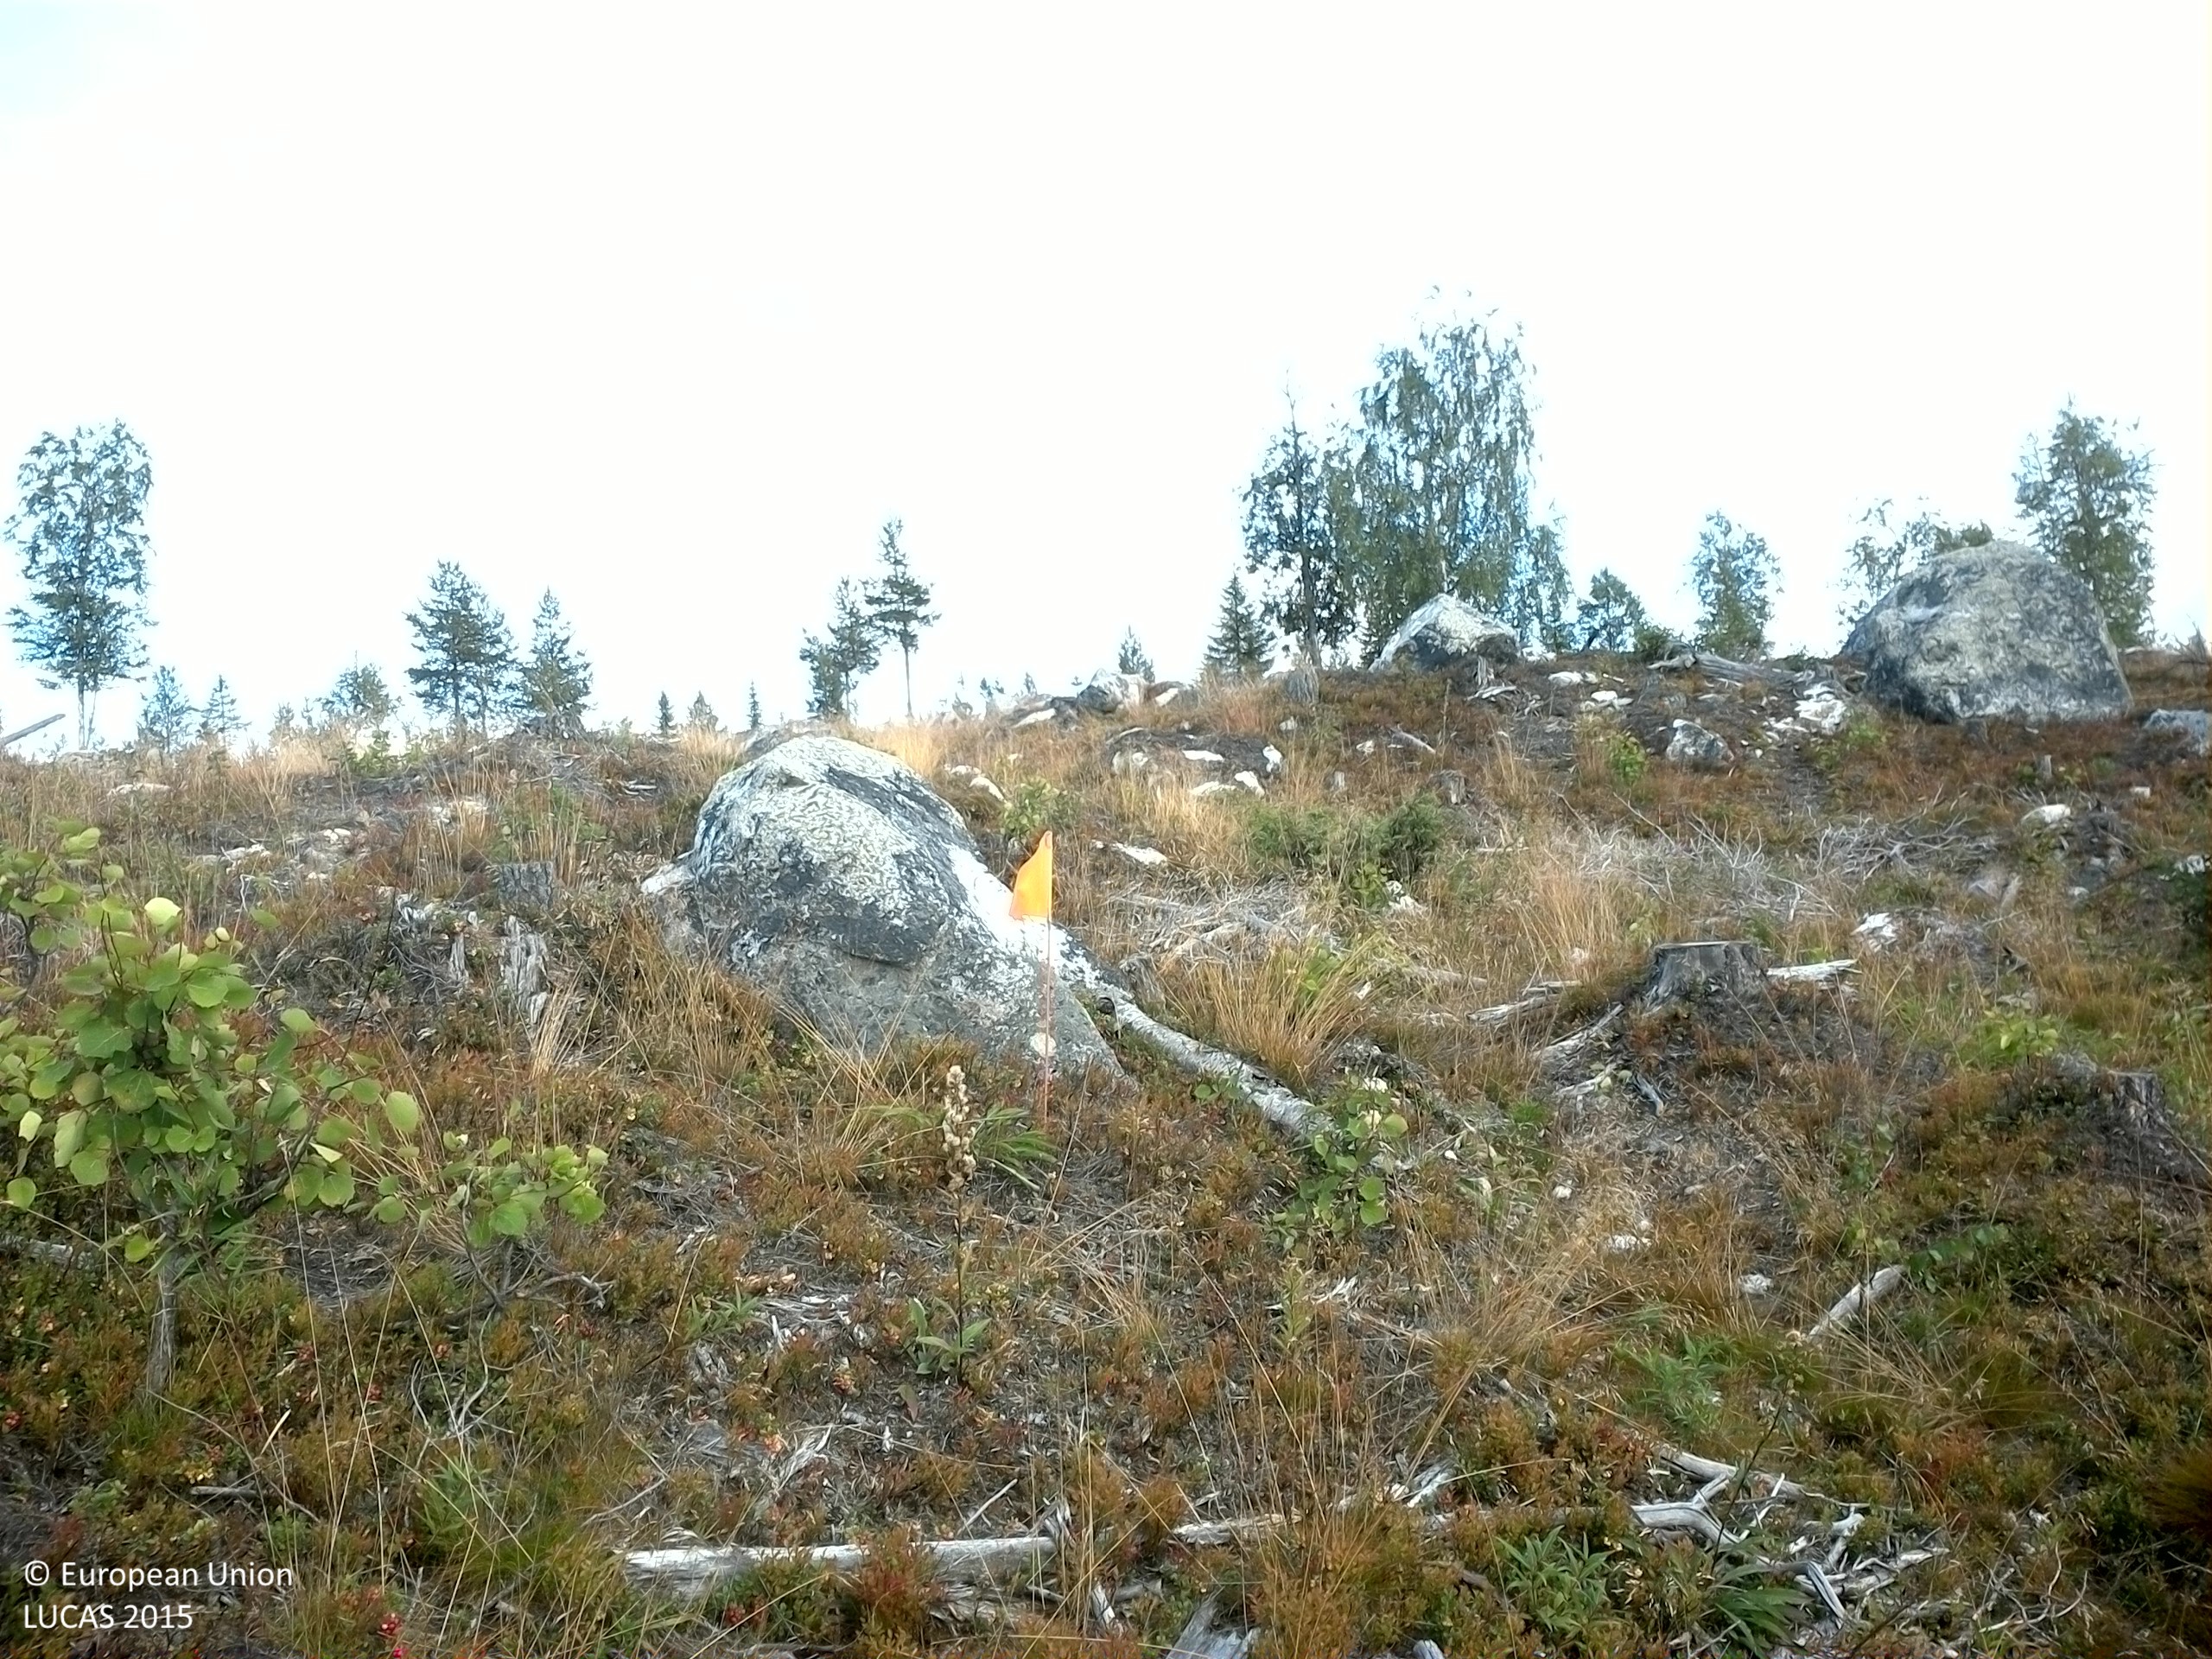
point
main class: Shrubland
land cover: Shrubland with sparse tree cover
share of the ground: 50 - 75 %
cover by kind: shrubs 60 %, herbaceous plants 20 %, lichens and mosses 10 %, broadleaved forest trees 5 %, unconsolidated bare surface 5 %
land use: Forestry
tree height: < 5 m
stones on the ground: > 50 %
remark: Clear cut
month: September
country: SE
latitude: 64.1655
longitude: 17.5178
